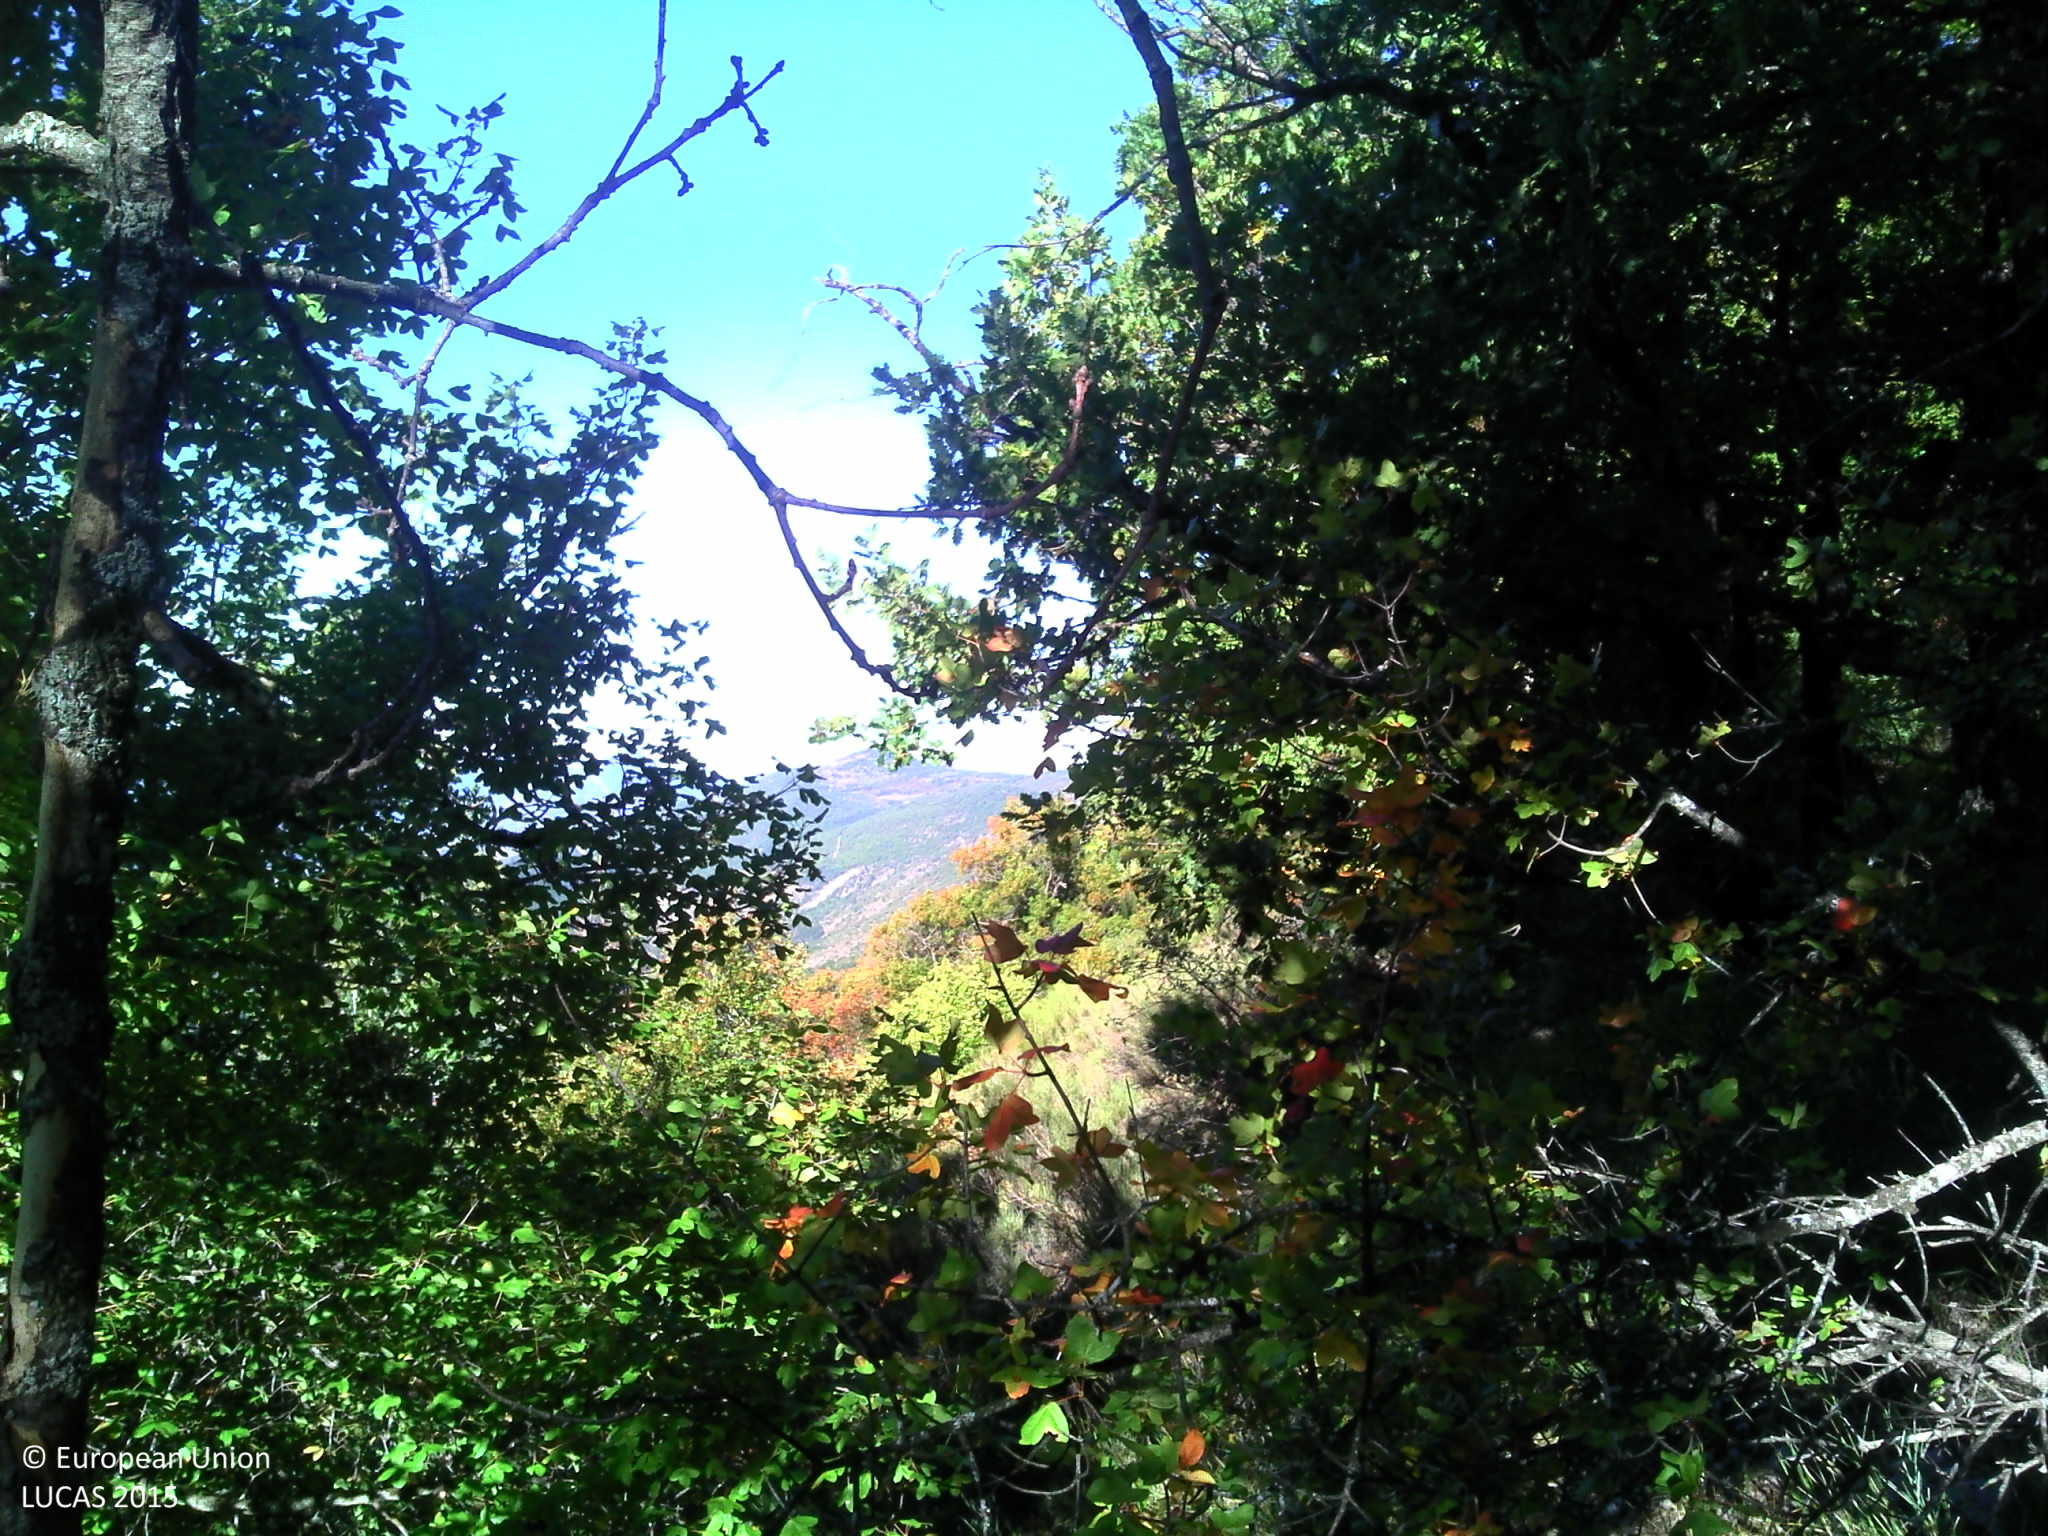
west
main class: Woodland
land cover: Broadleaved woodland
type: thermophilous deciduous forest
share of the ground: > 75 %
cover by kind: broadleaved forest trees 75 %, herbaceous plants 20 %, coniferous forest trees 5 %
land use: Semi-natural and natural areas not in use
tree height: > 5 m
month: September
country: FR
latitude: 44.3075
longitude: 5.5071
